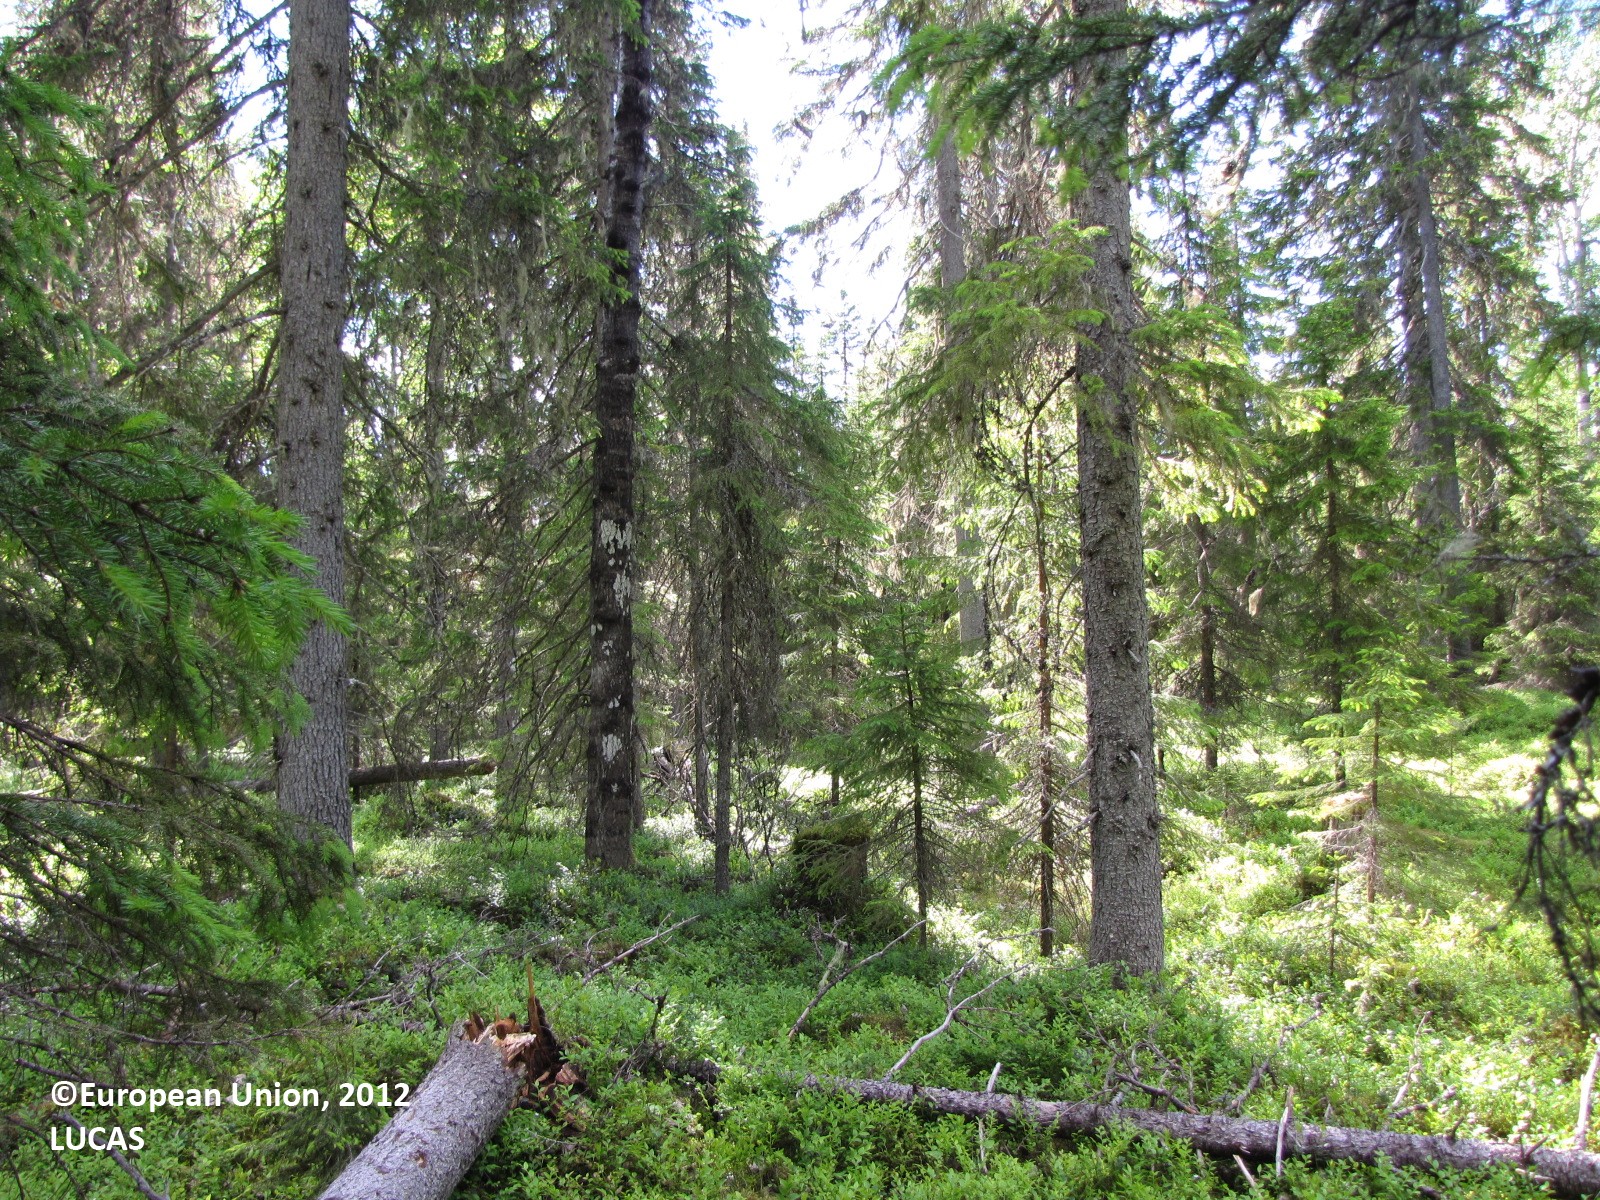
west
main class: Woodland
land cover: Spruce dominated coniferous woodland
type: boreal forest
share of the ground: 50 - 75 %
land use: Forestry
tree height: > 5 m
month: July
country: FI
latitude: 66.2728
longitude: 25.1373
